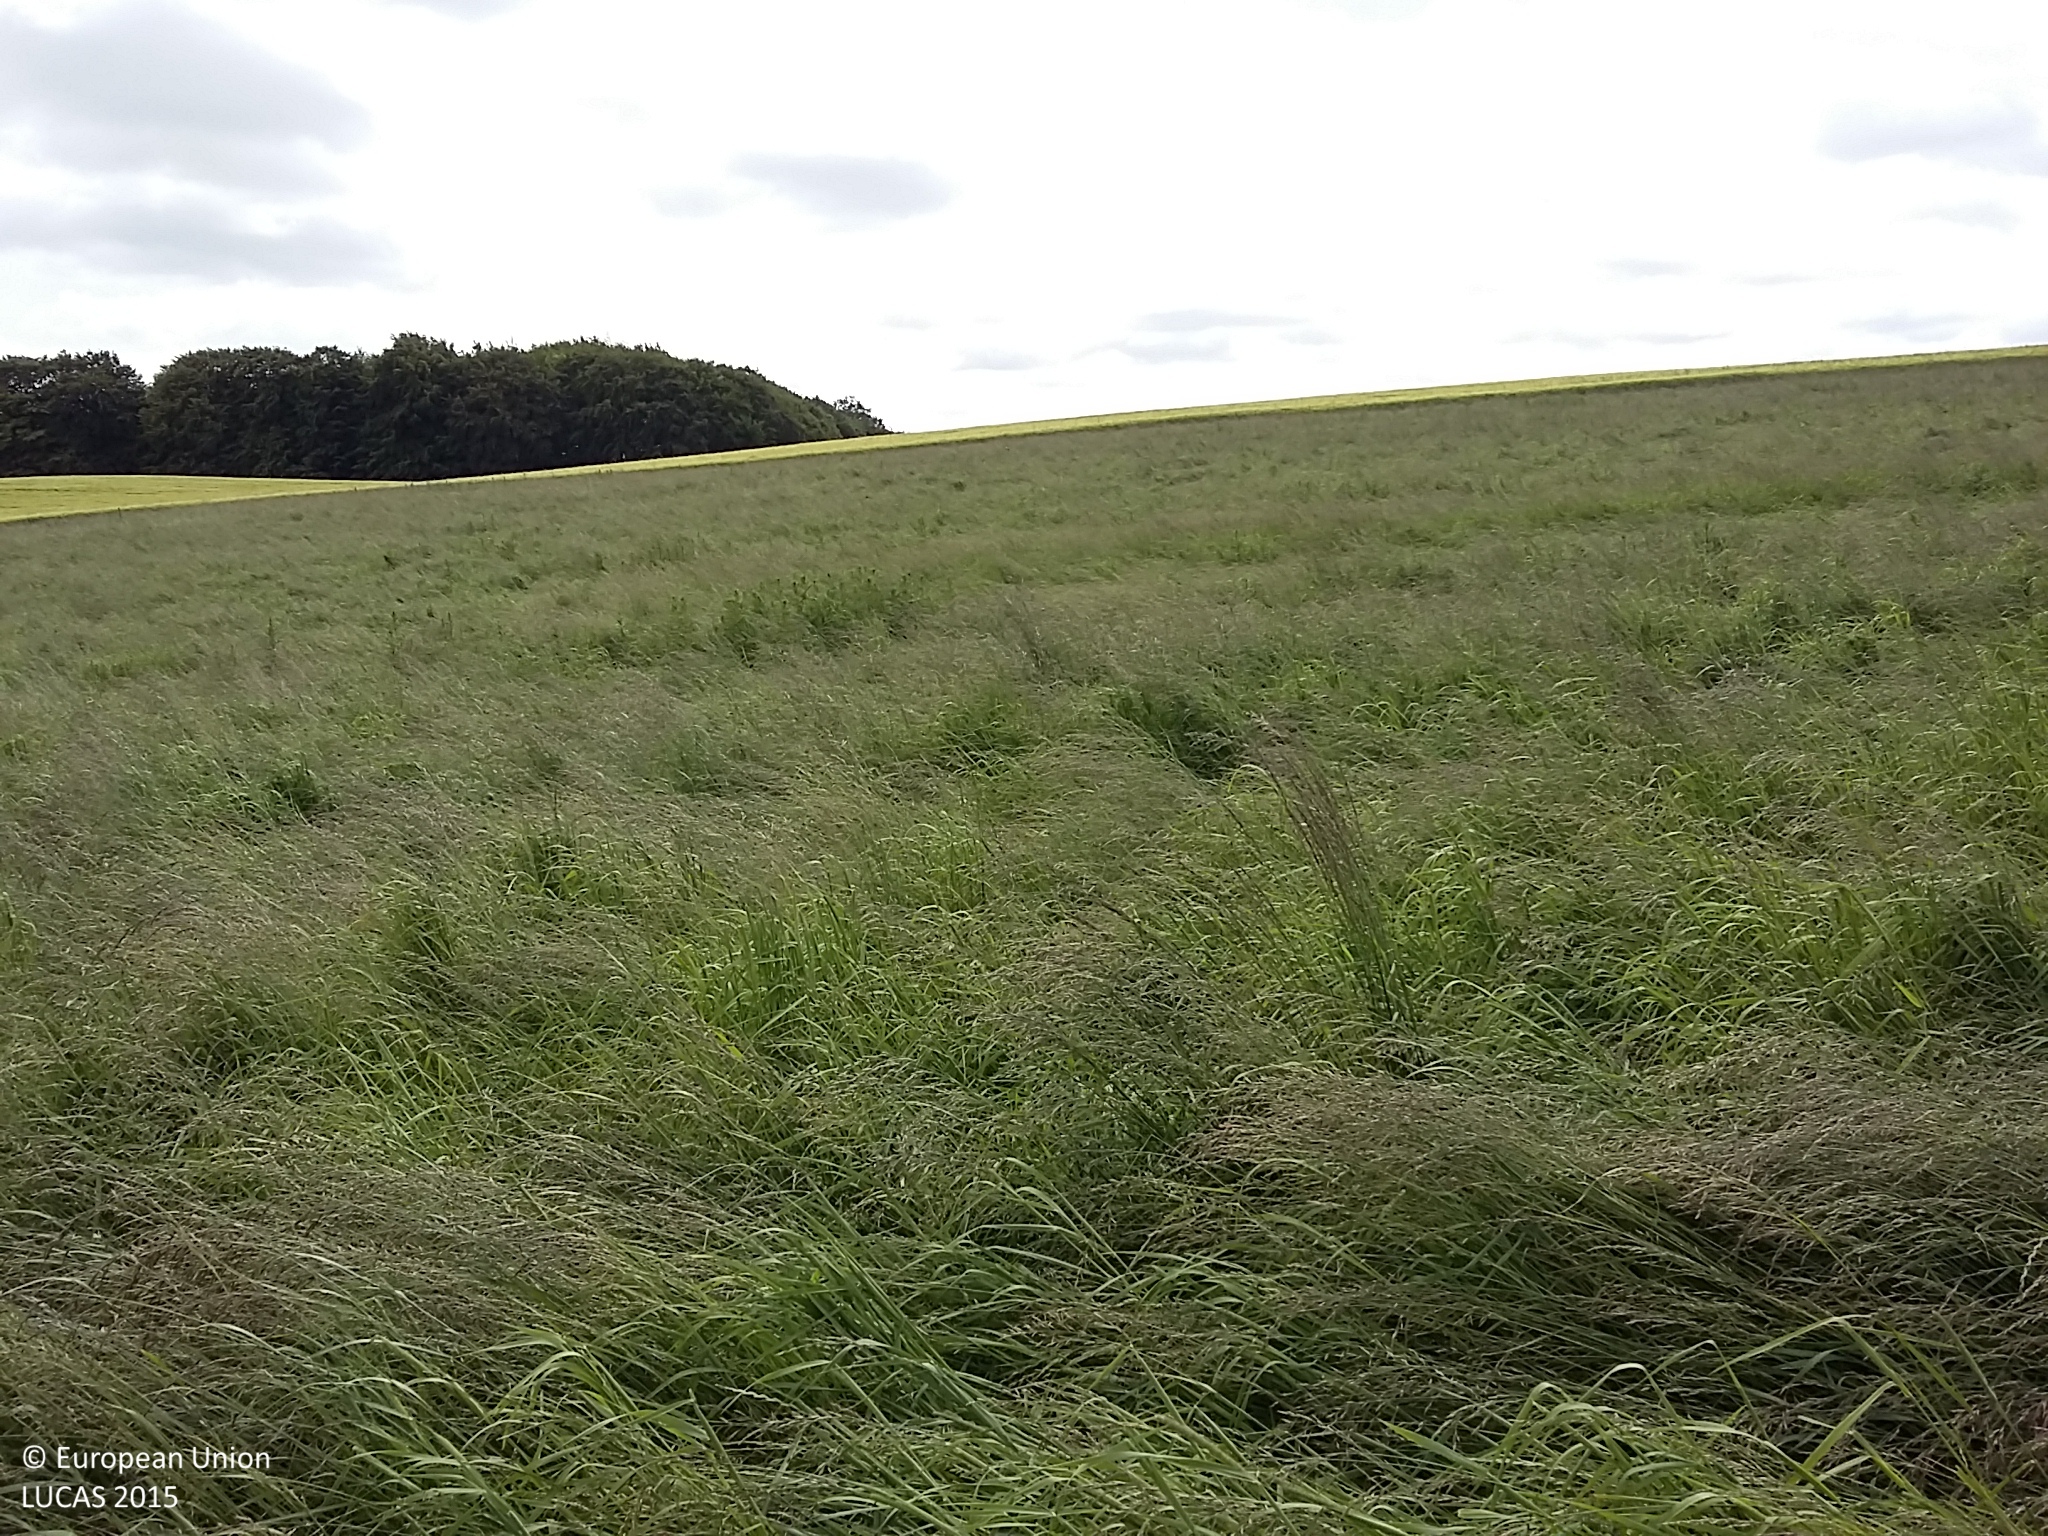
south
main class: Cropland
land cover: Temporary grasslands
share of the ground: > 75 %
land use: Agriculture (excluding fallow land and kitchen gardens)
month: June
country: DK
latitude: 55.2687
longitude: 10.7705
